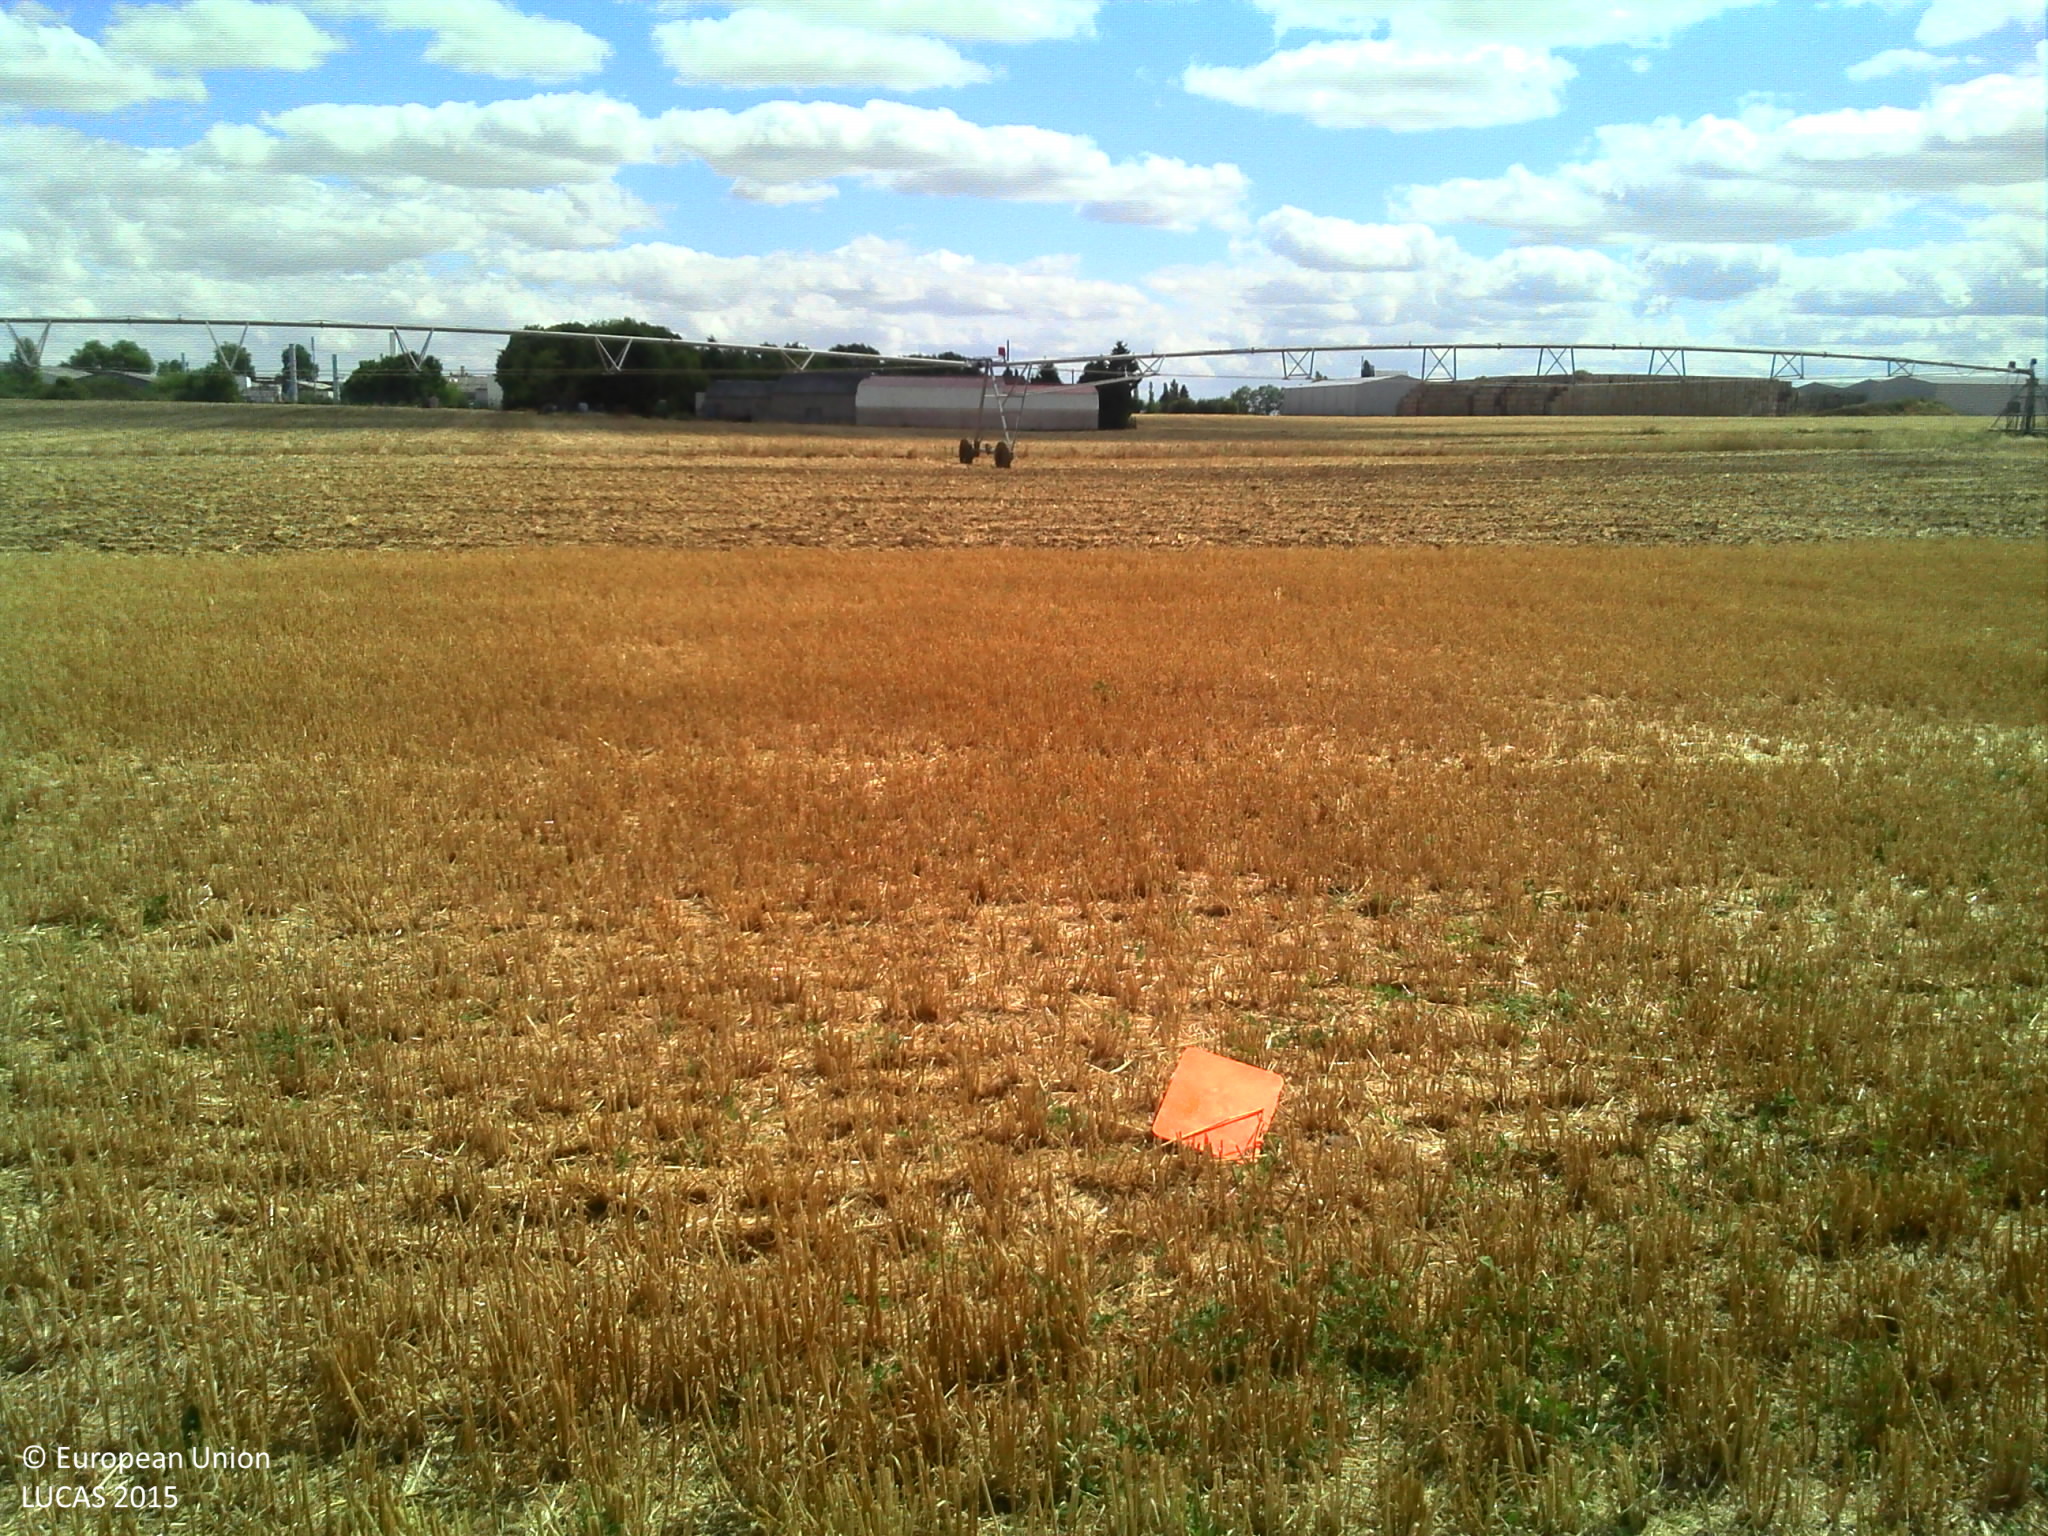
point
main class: Cropland
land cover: Common wheat
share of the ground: > 75 %
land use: Agriculture (excluding fallow land and kitchen gardens)
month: August
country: FR
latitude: 48.2043
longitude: 2.0080
